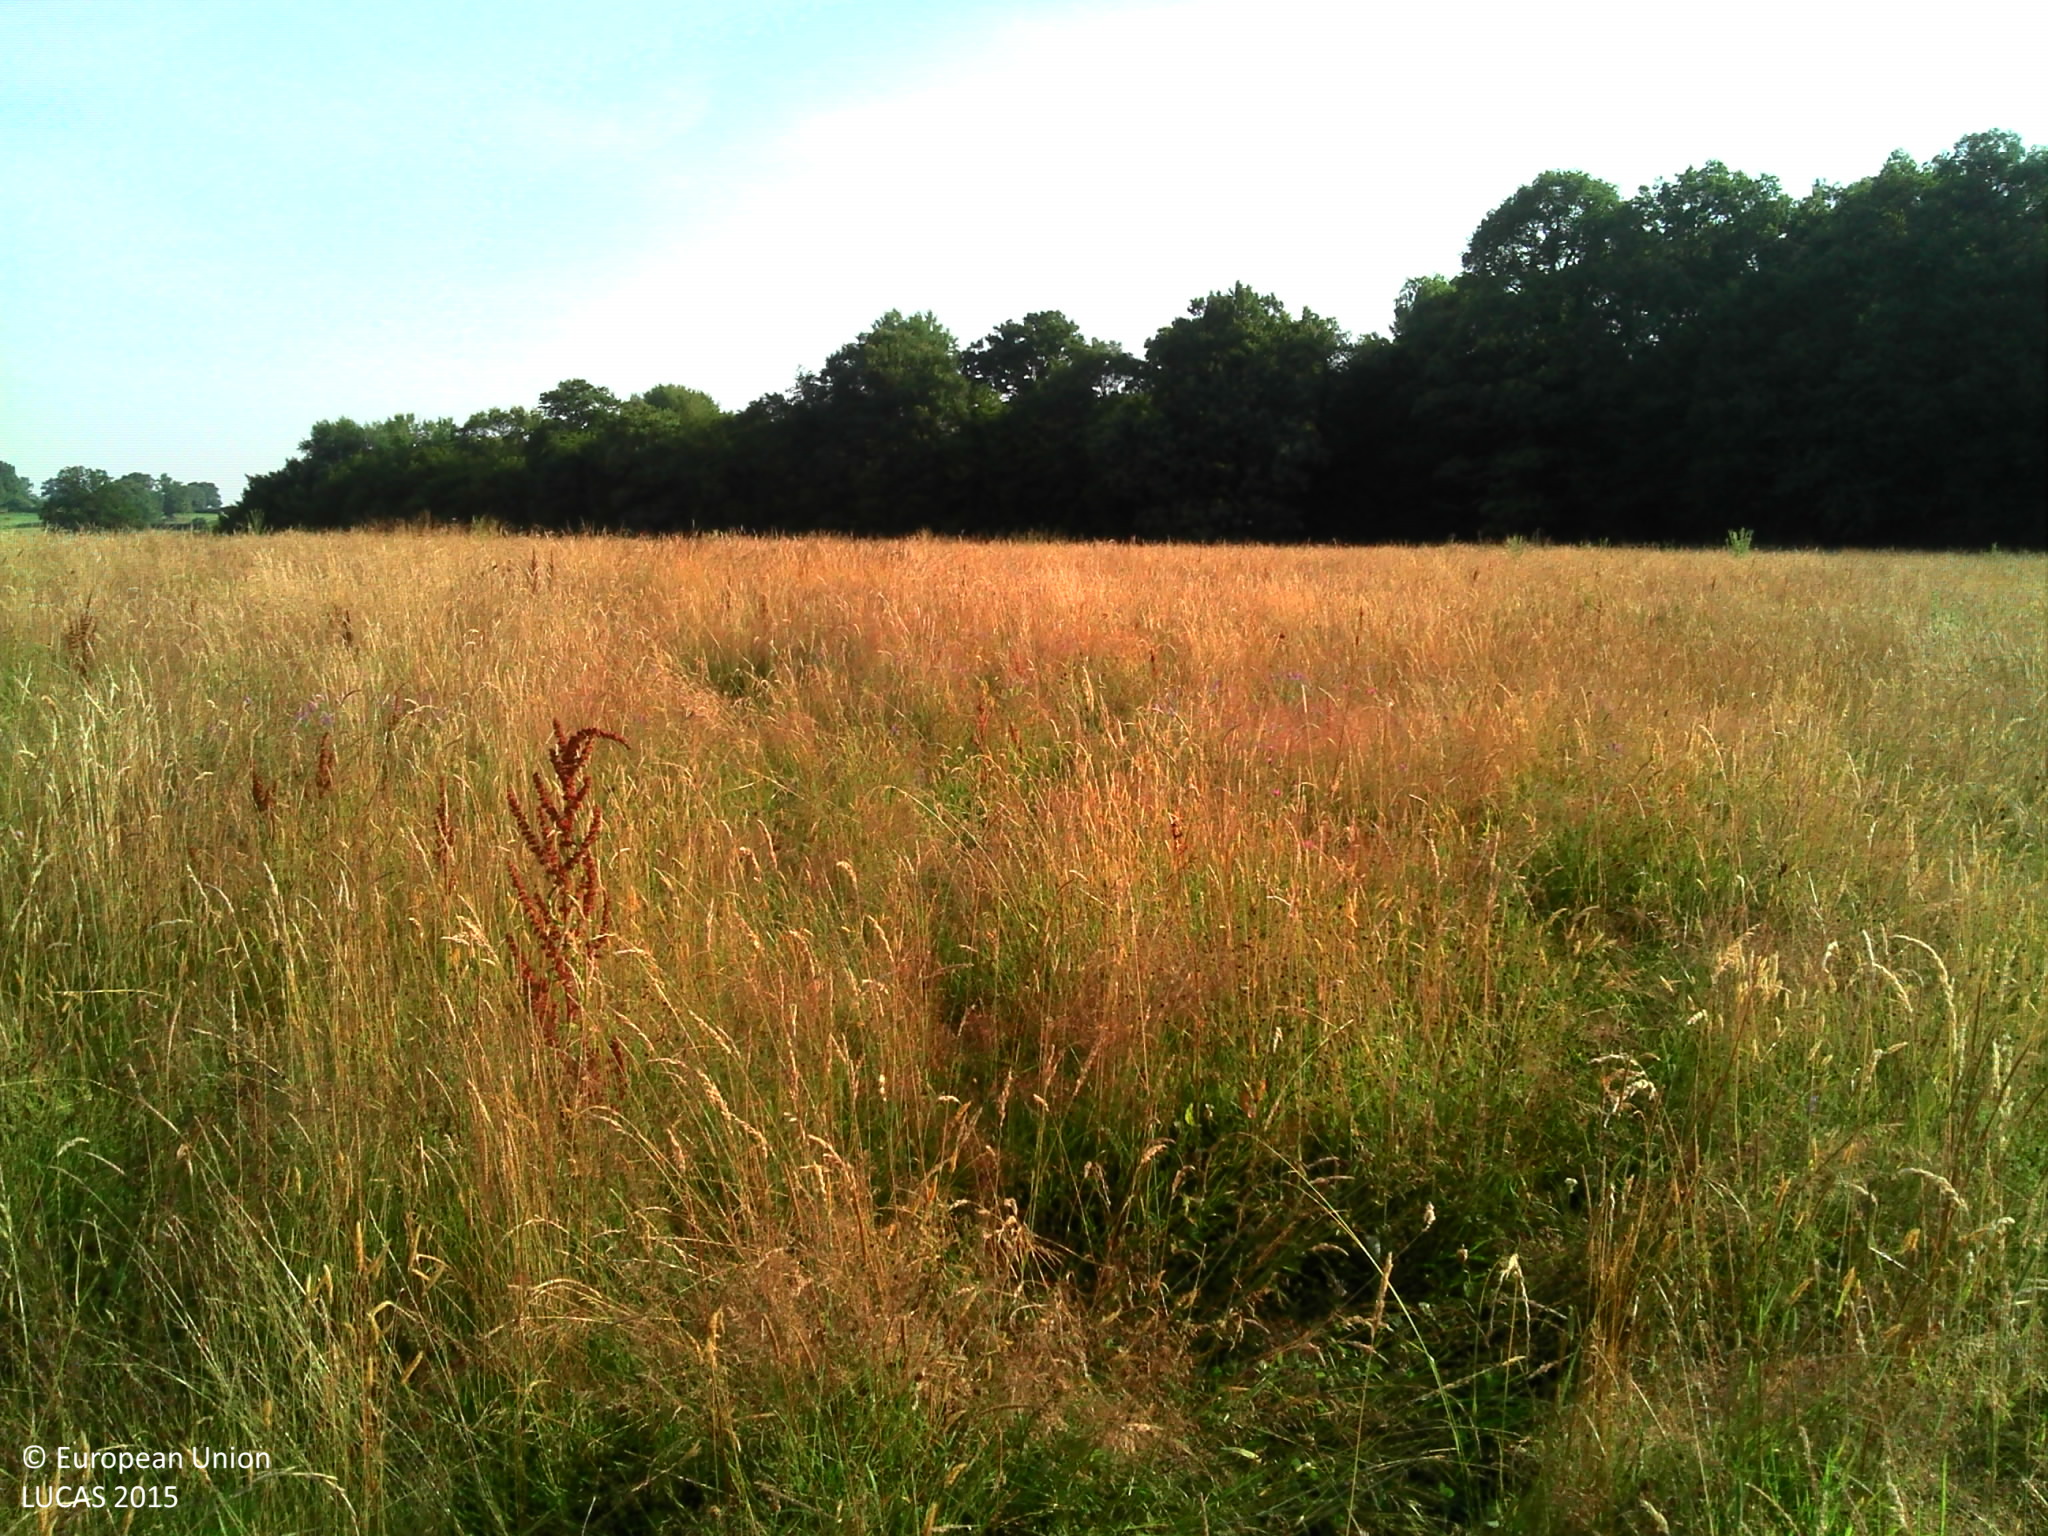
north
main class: Grassland
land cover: Grassland without tree/shrub cover
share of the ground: > 75 %
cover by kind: herbaceous plants 100 %
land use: Agriculture (excluding fallow land and kitchen gardens)
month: July
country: FR
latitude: 47.1873
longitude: 3.5702
